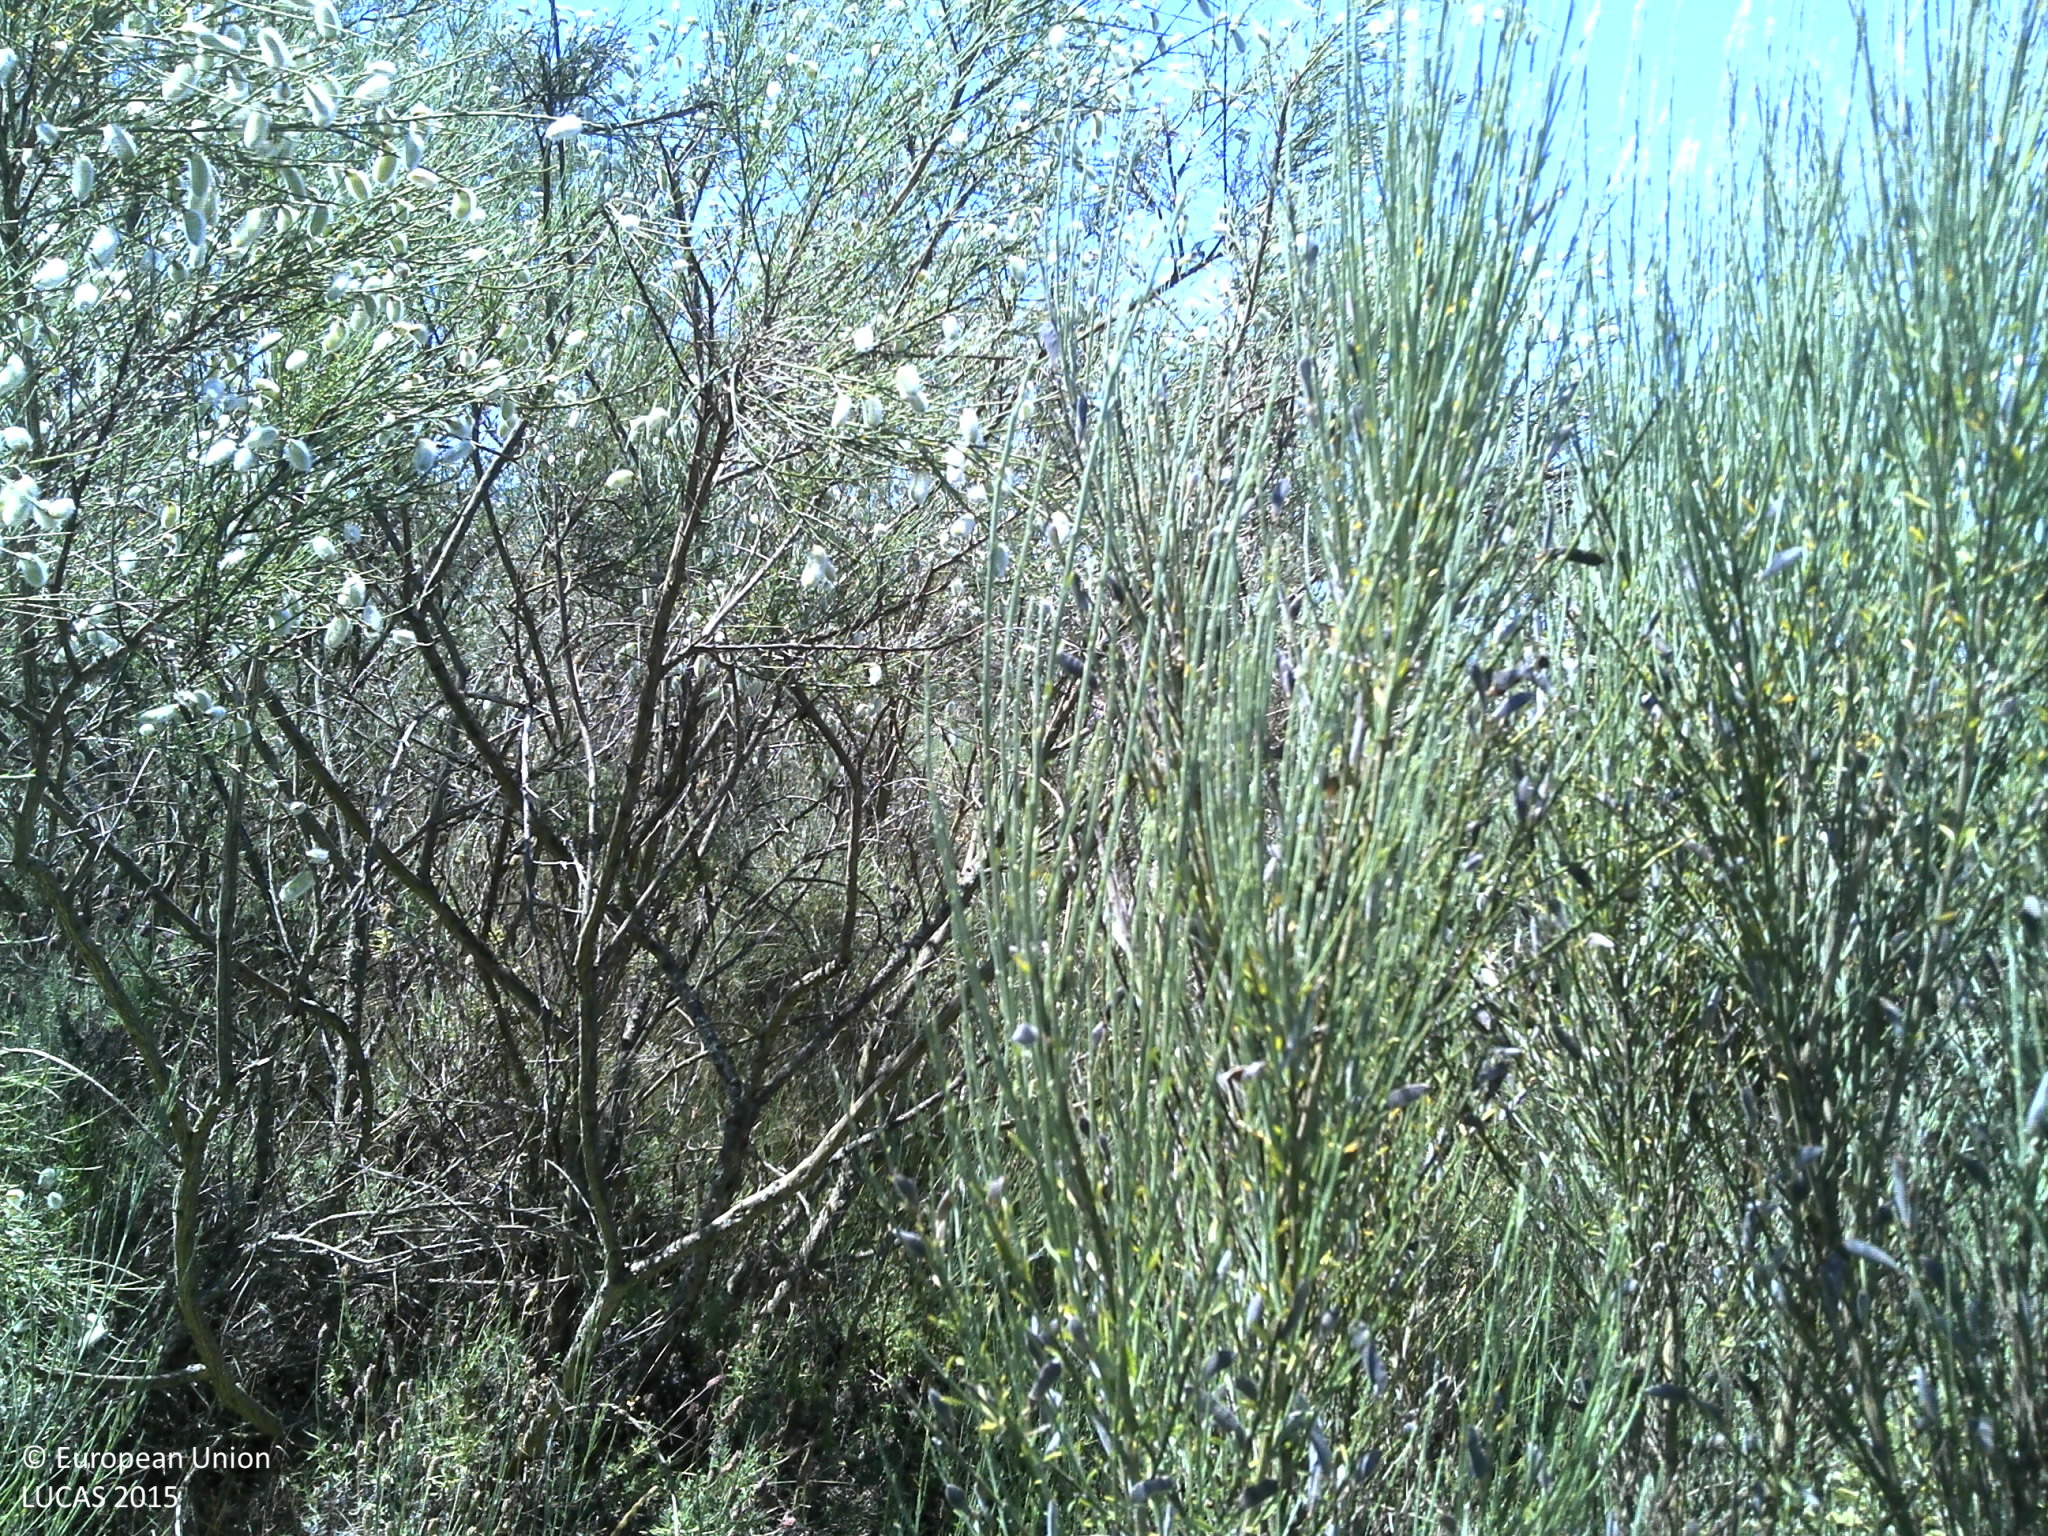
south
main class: Shrubland
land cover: Shrubland without tree cover
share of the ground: > 75 %
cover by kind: shrubs 90 %, herbaceous plants 10 %
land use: Semi-natural and natural areas not in use
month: June
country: PT
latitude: 41.5300
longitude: -6.9282
